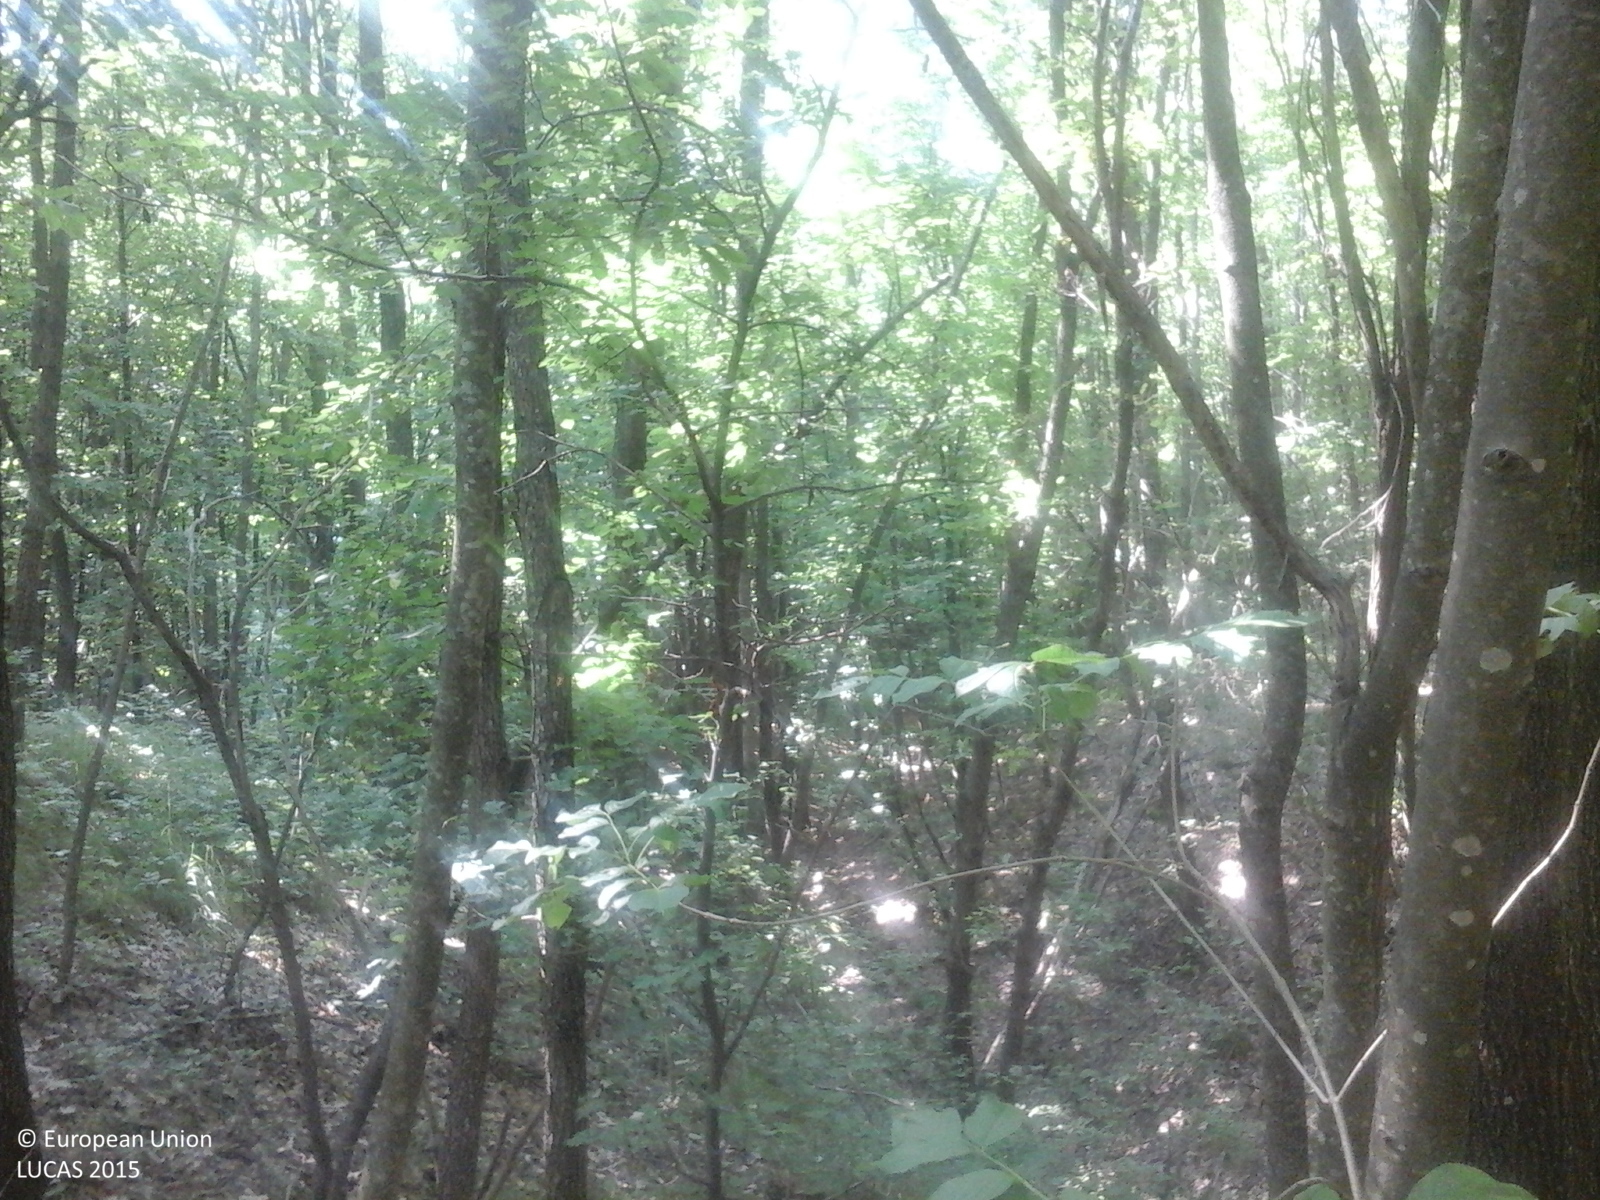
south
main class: Woodland
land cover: Broadleaved woodland
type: beech forest
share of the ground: > 75 %
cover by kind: broadleaved forest trees 100 %
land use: Forestry
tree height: > 5 m
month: July
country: RO
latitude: 44.7689
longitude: 24.3869
